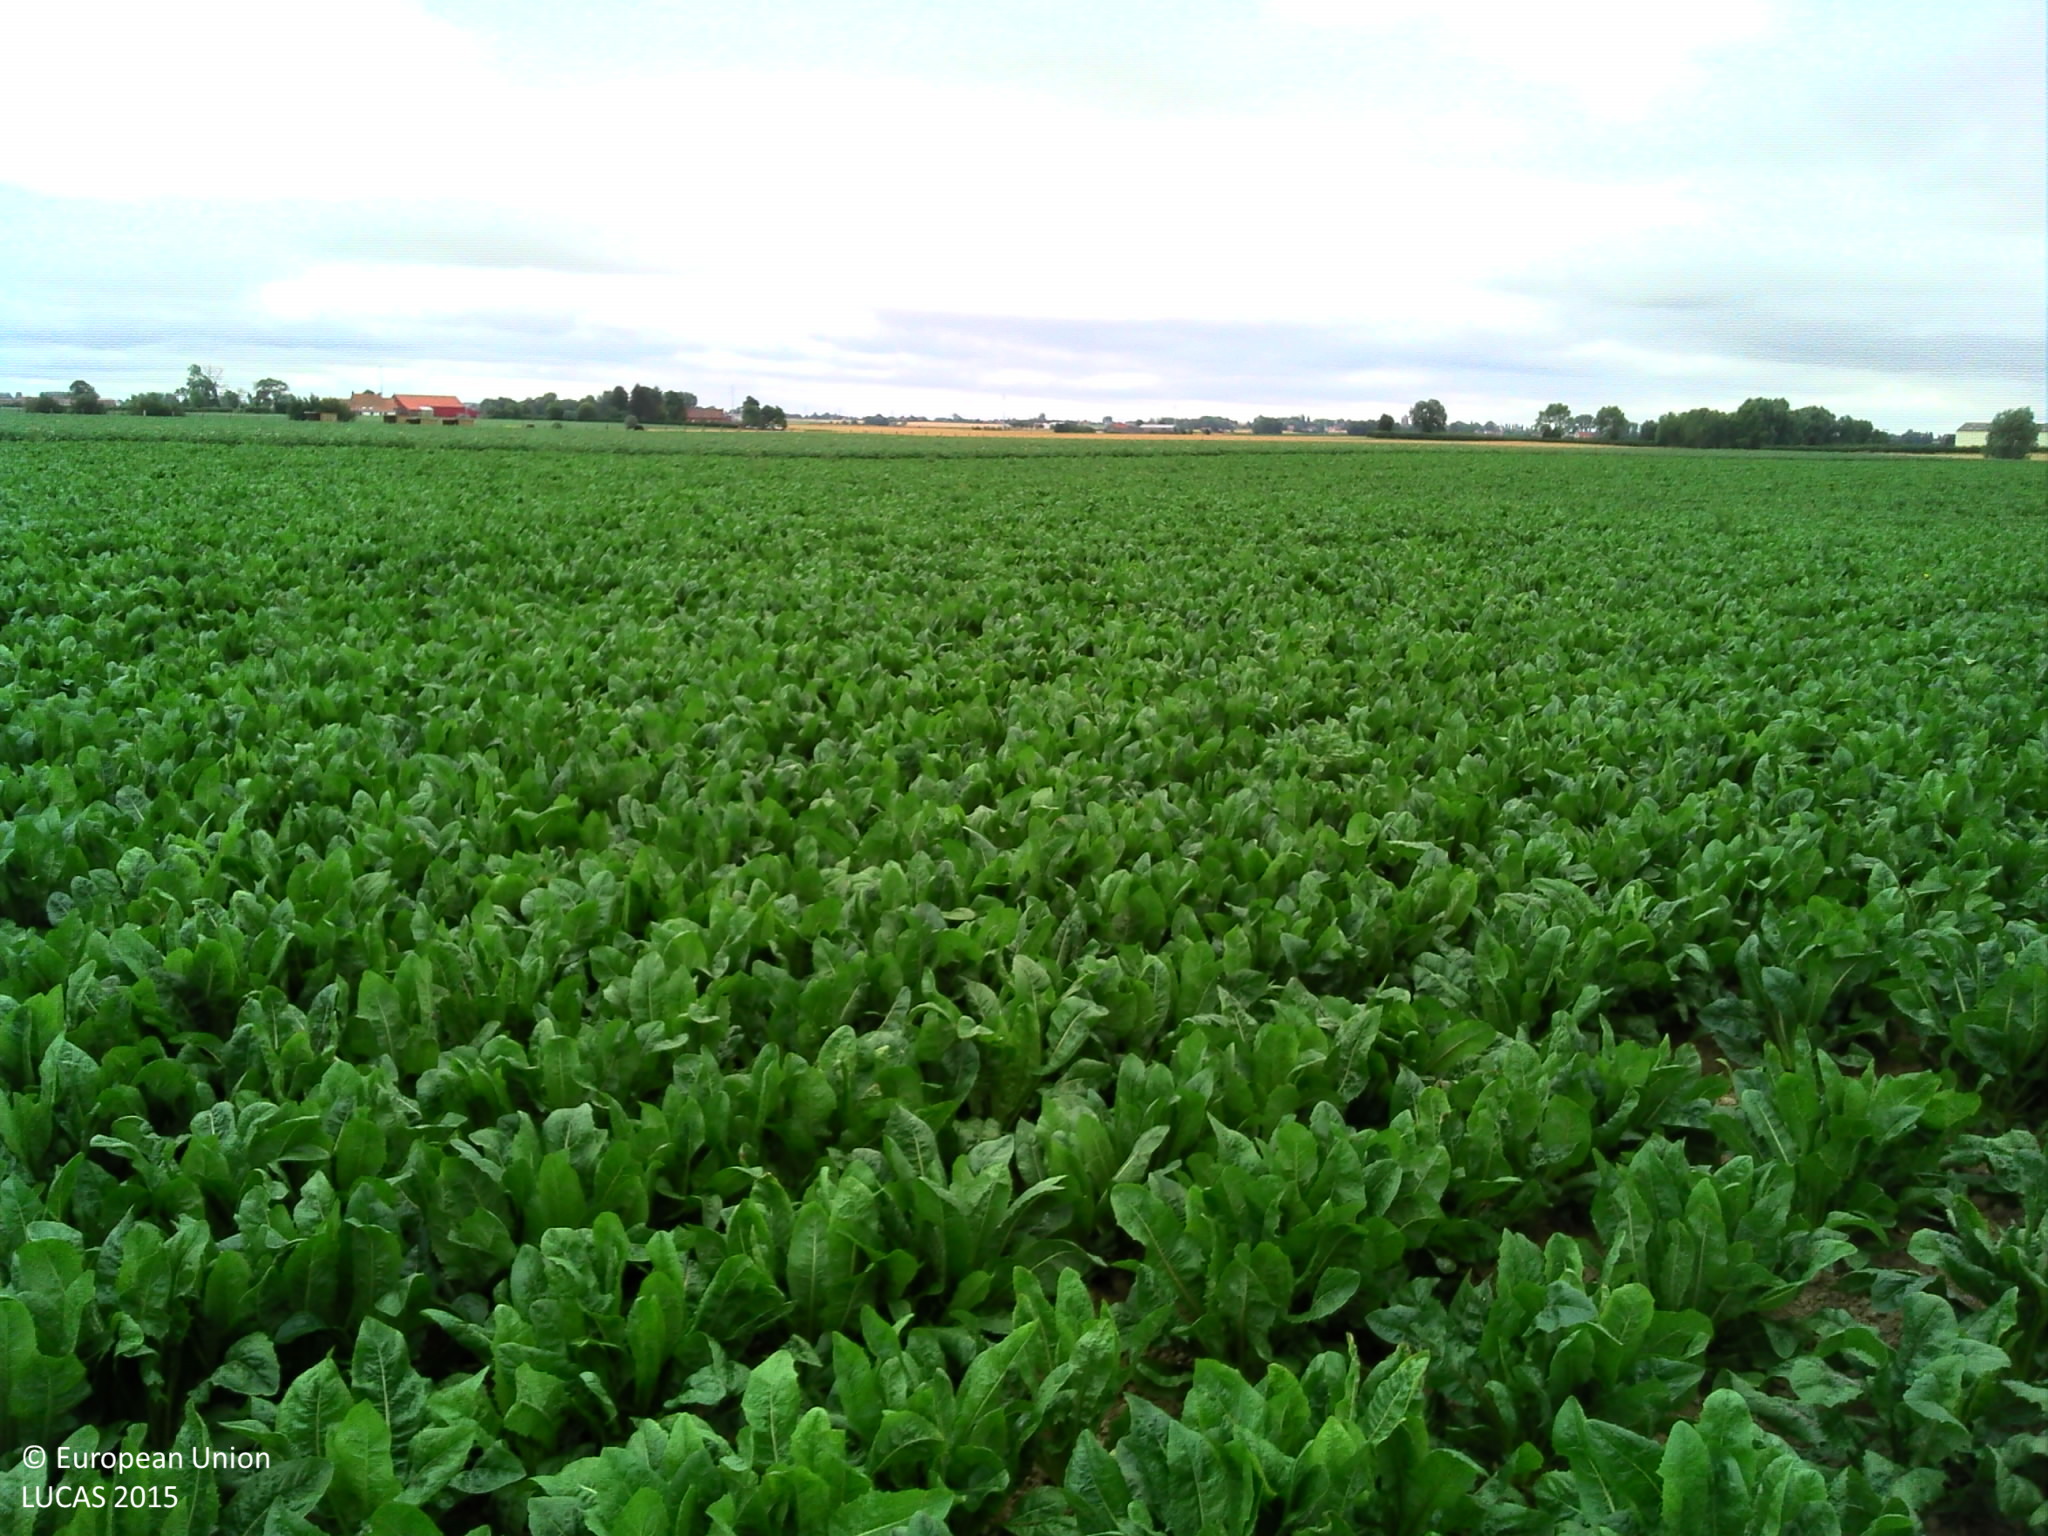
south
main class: Cropland
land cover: Sugar beet
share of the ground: > 75 %
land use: Agriculture (excluding fallow land and kitchen gardens)
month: July
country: FR
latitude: 50.8686
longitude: 2.3845
